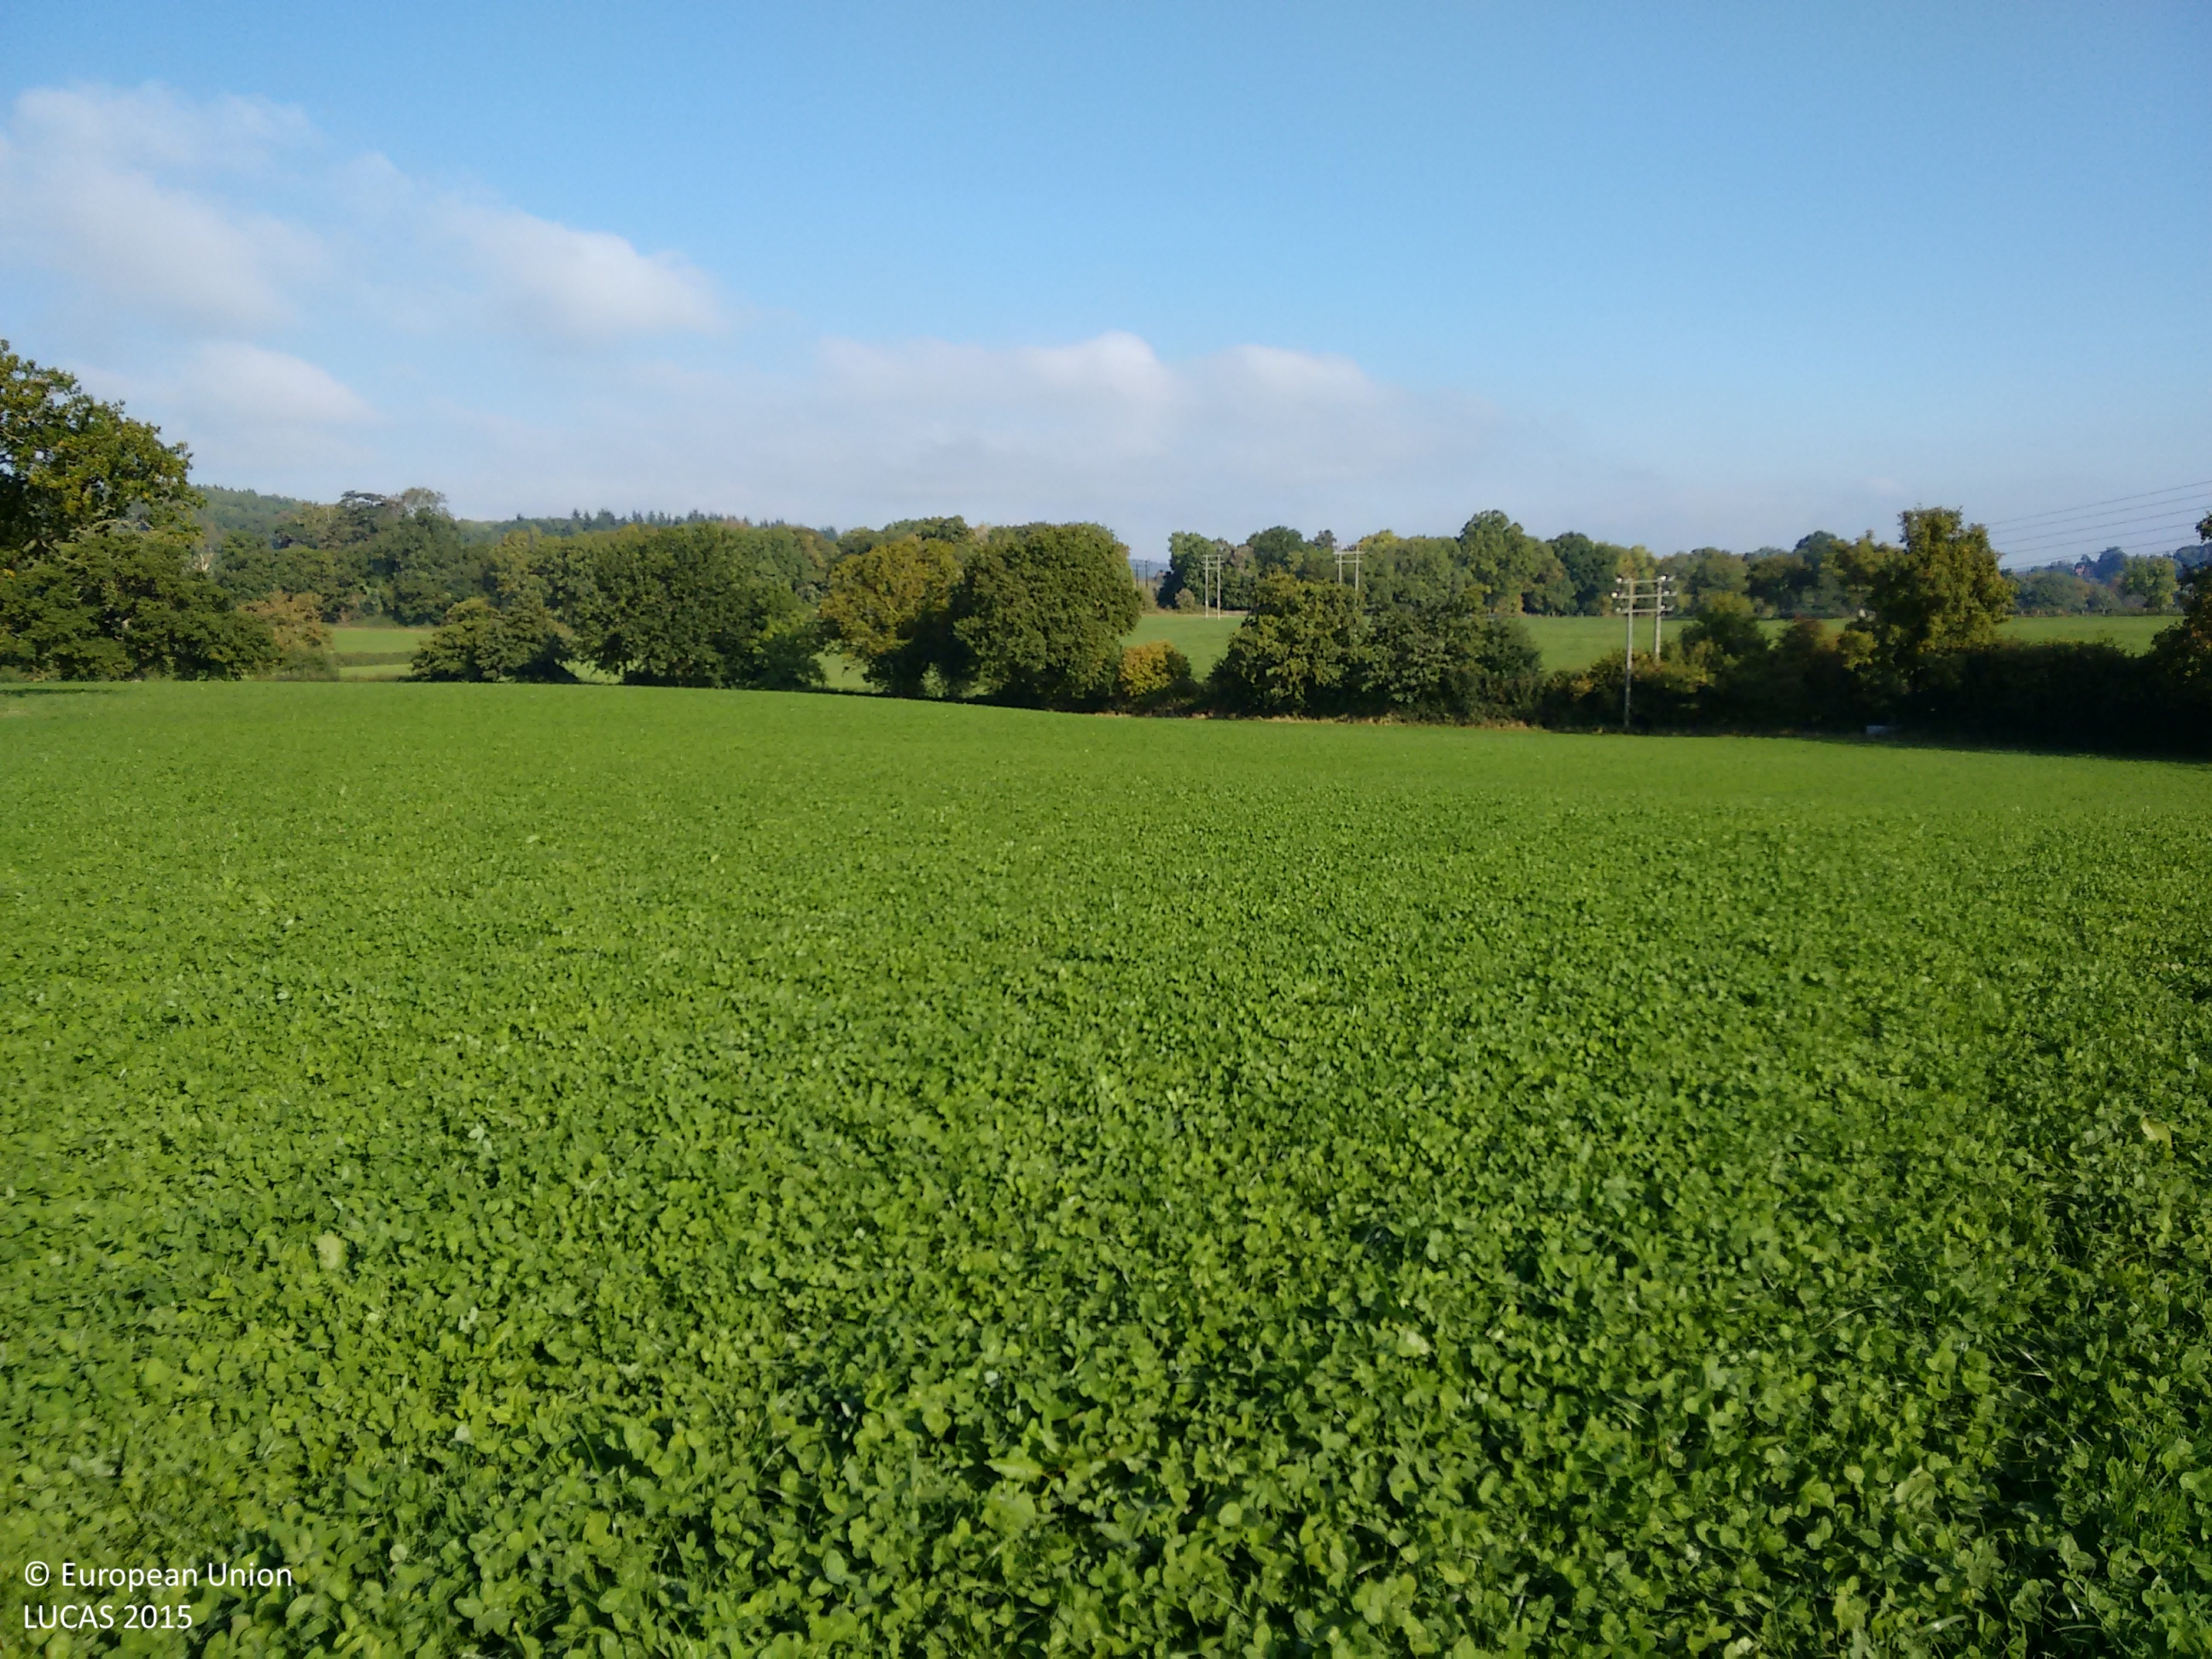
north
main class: Cropland
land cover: Clovers
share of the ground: > 75 %
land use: Agriculture (excluding fallow land and kitchen gardens)
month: September
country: GB
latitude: 51.7904
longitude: -2.4617
